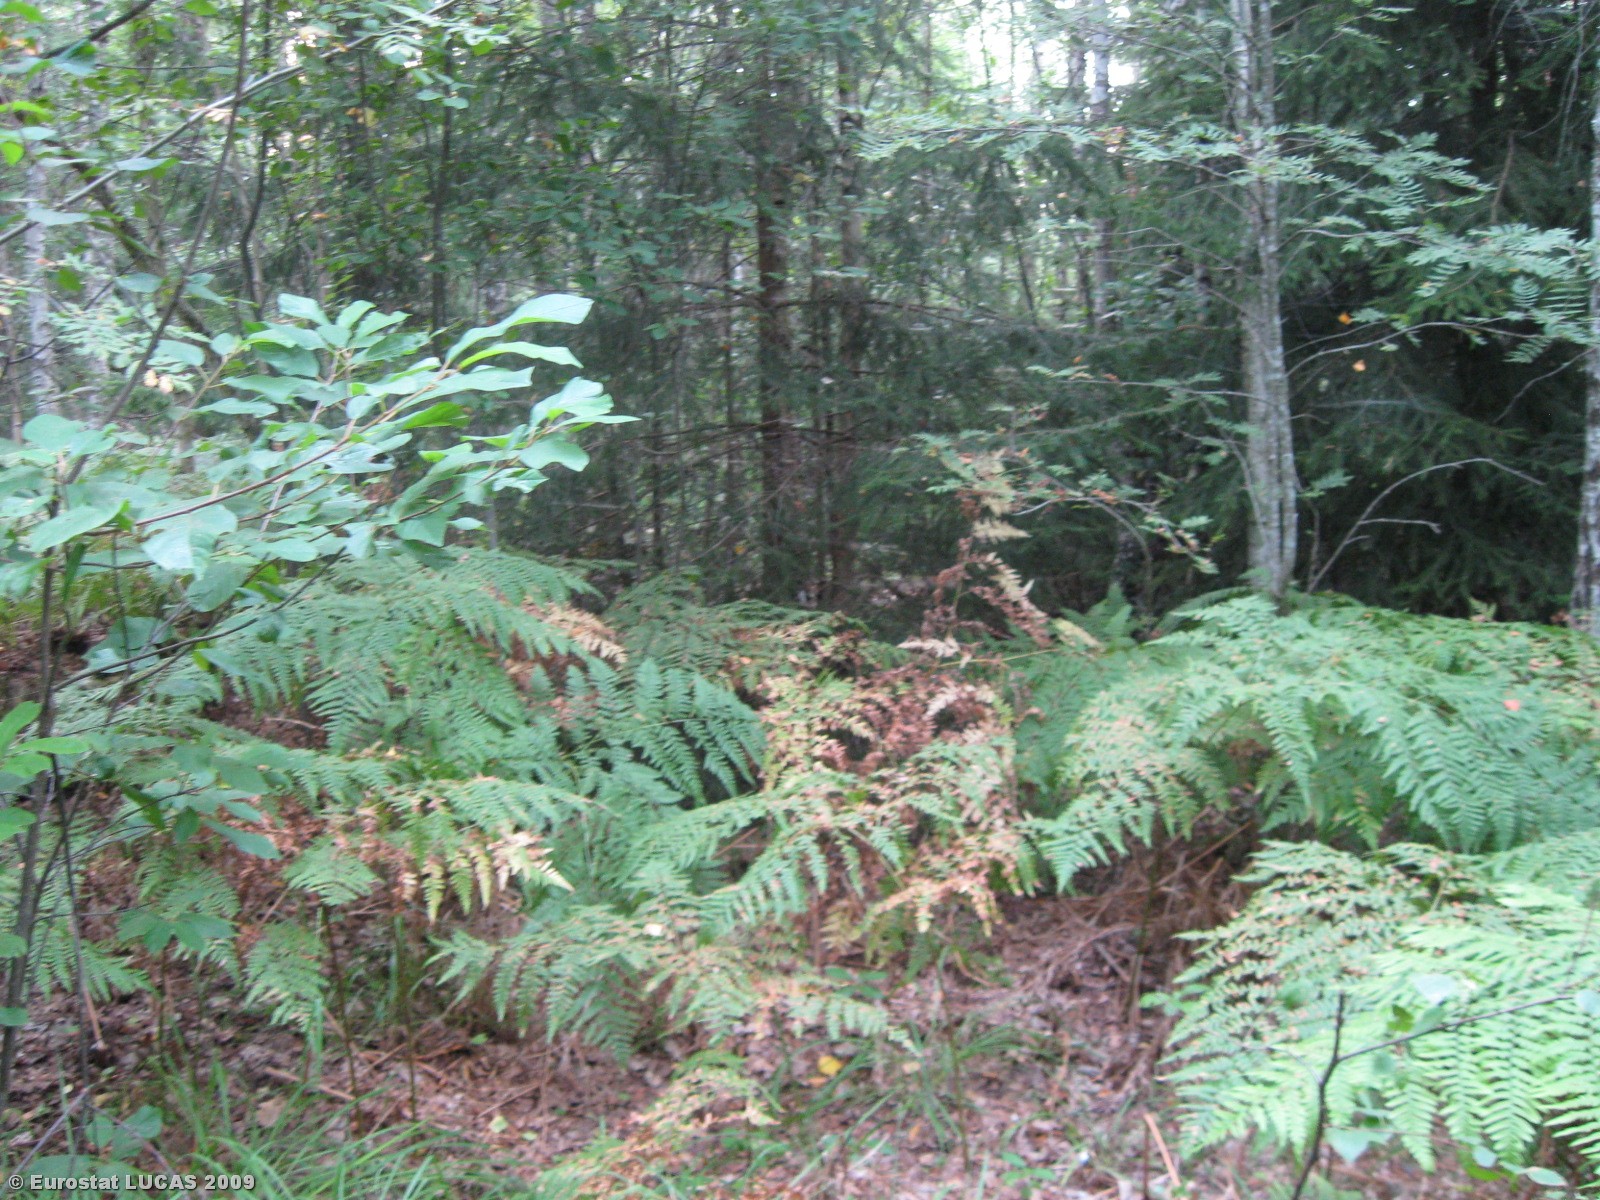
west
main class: Woodland
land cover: Mixed woodland
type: hemiboreal forest and nemoral coniferous forest and mixed broadleaved-coniferous forest
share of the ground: > 75 %
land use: Forestry
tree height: > 5 m
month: August
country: LT
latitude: 55.0915
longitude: 22.5830
